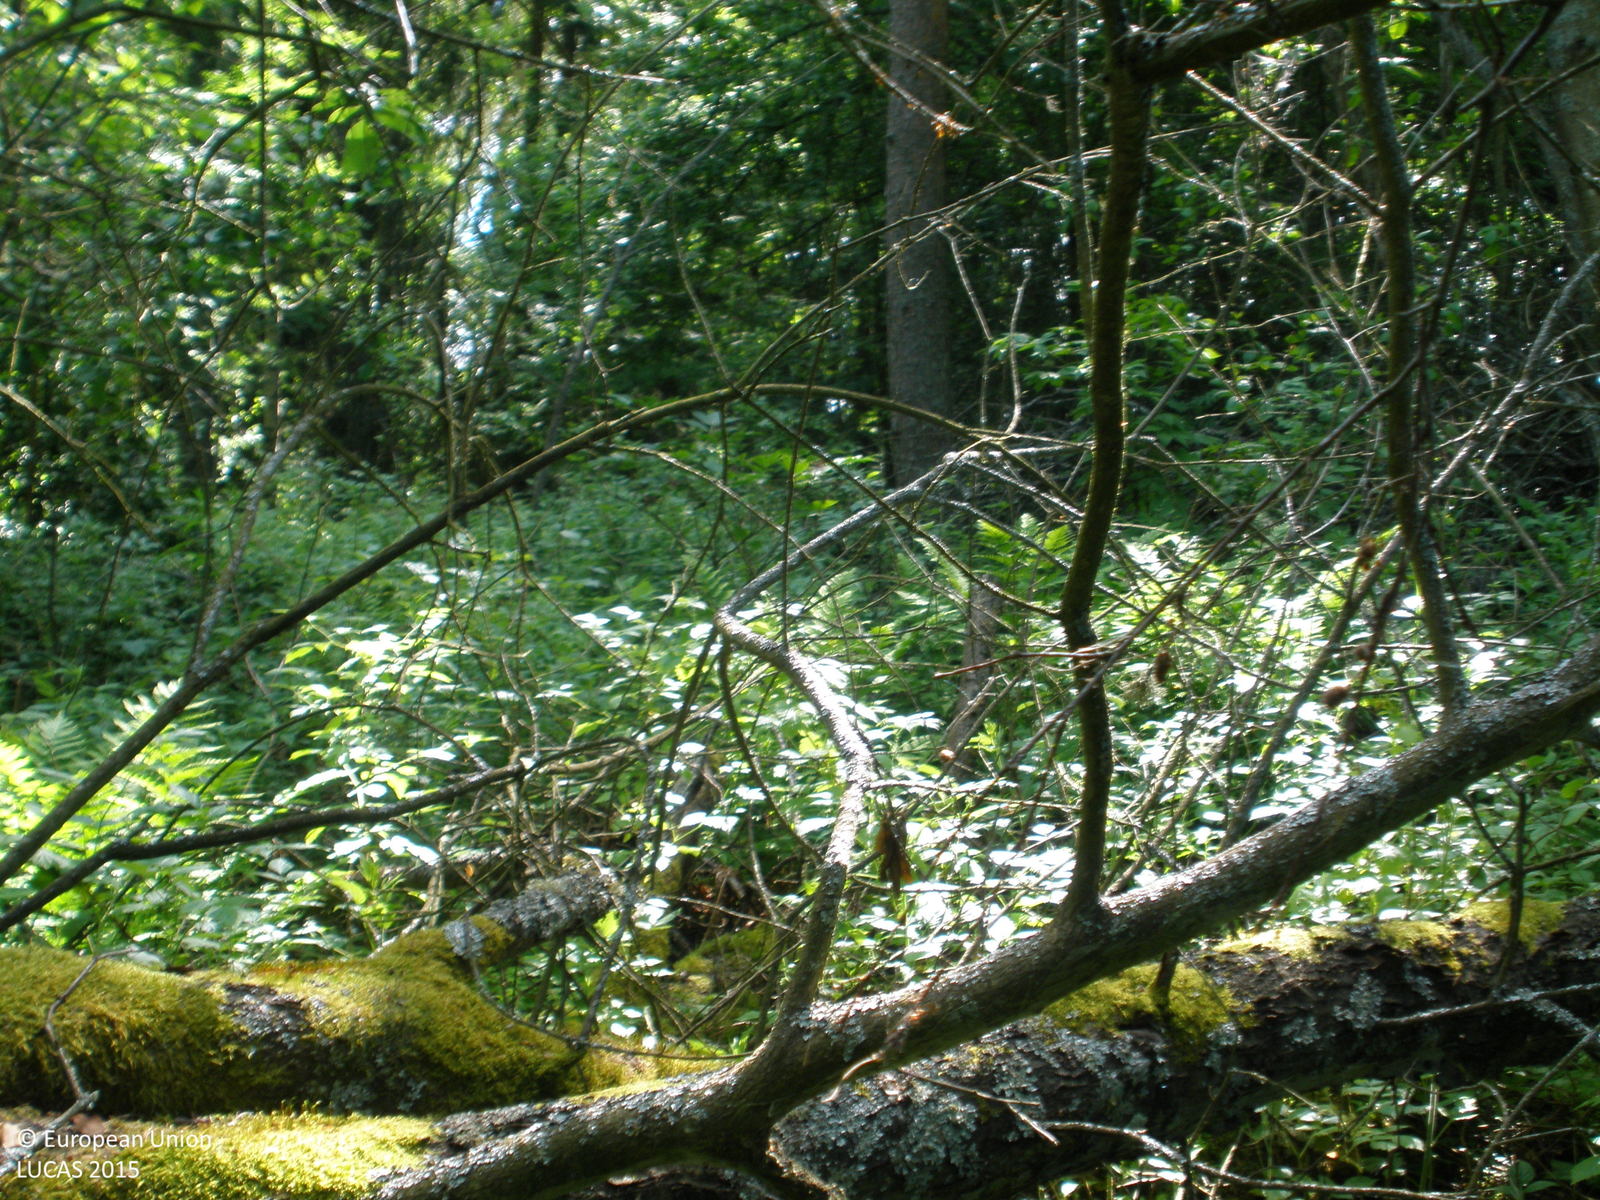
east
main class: Woodland
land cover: Broadleaved woodland
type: boreal forest
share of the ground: > 75 %
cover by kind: broadleaved forest trees 80 %, shrubs 10 %, coniferous forest trees 5 %, herbaceous plants 5 %
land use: Forestry
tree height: > 5 m
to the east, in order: Broadleaved woodland; Other mixed woodland; Broadleaved woodland; Inland marshes; Inland fresh water bodies; Inland marshes; Inland fresh water bodies
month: June
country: FI
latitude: 61.3564
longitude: 24.2891
